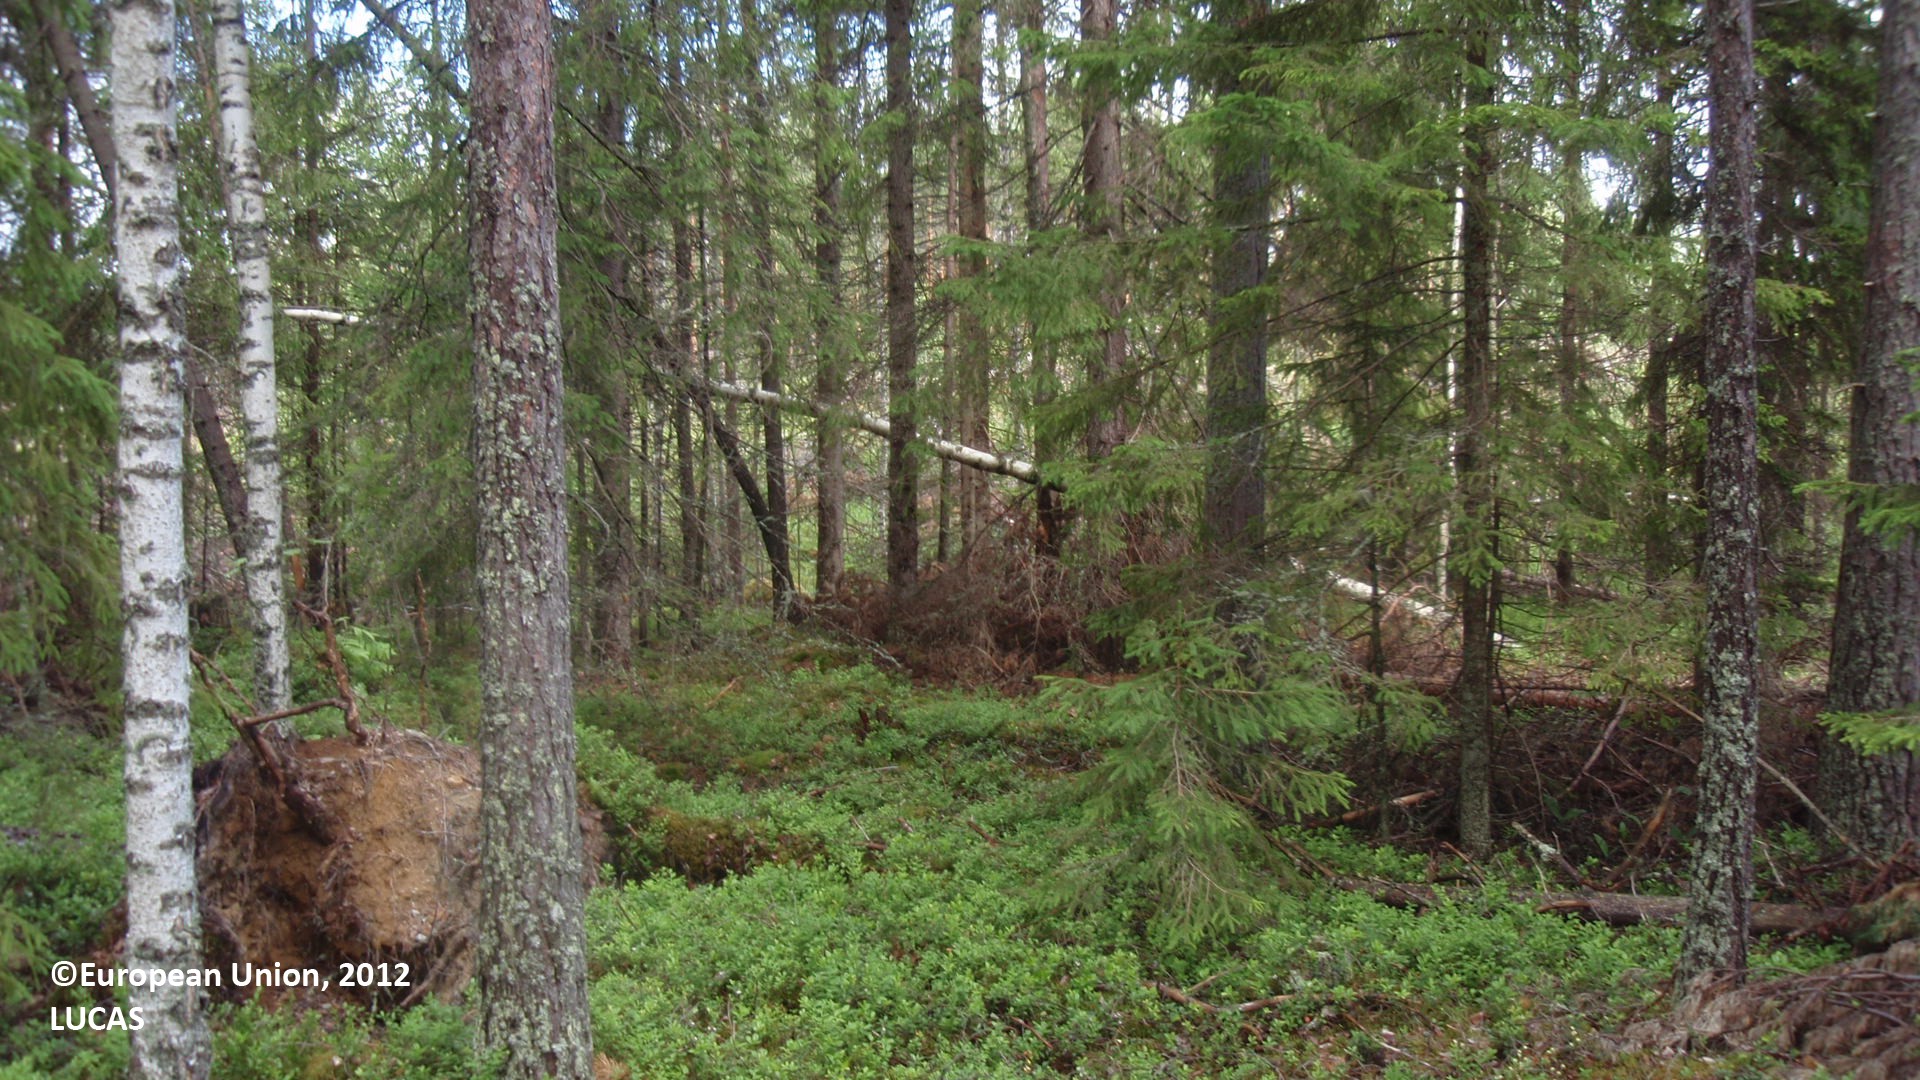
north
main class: Woodland
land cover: Pine dominated mixed woodland
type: boreal forest
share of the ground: 50 - 75 %
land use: Forestry
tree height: > 5 m
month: July
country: FI
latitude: 61.6277
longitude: 28.8422
